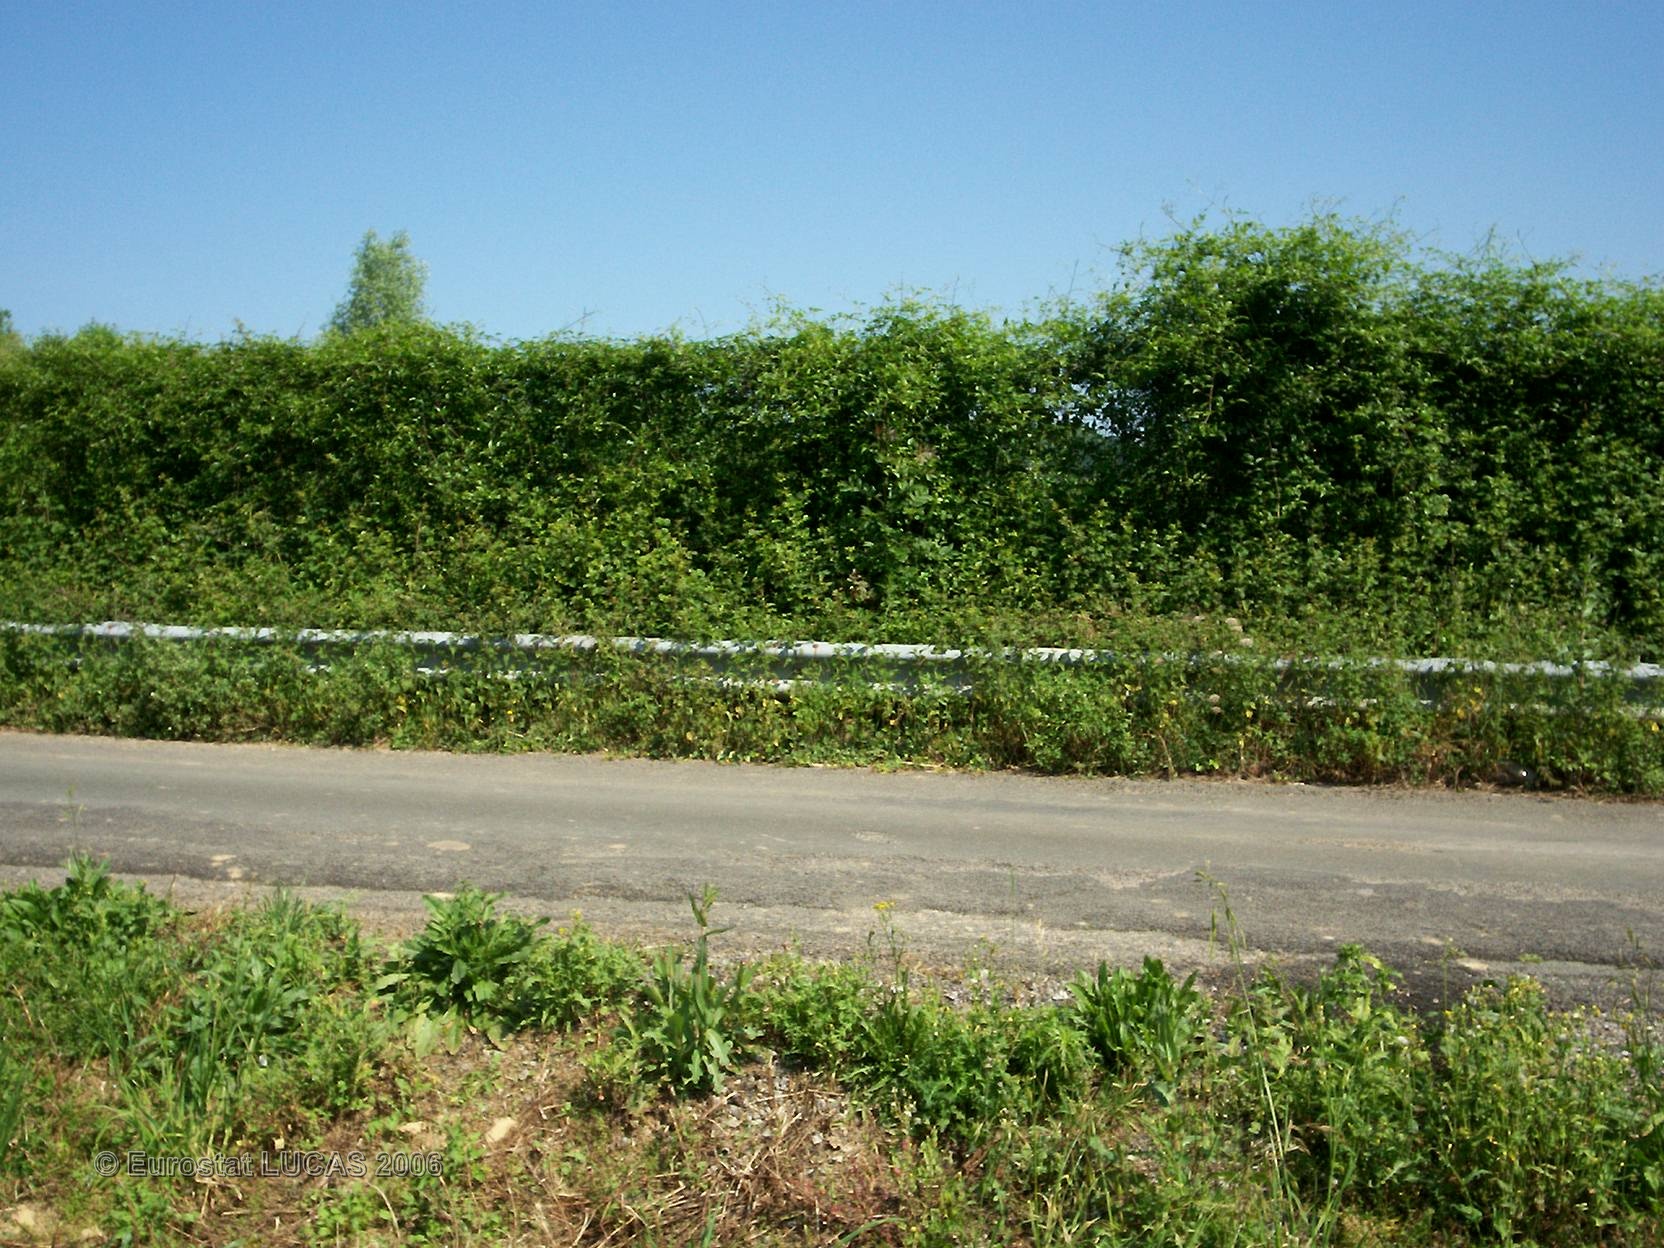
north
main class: Grassland
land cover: Grassland without tree/shrub cover
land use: Agriculture (excluding fallow land and kitchen gardens)
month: May
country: FR
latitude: 43.3579
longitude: -1.7044
